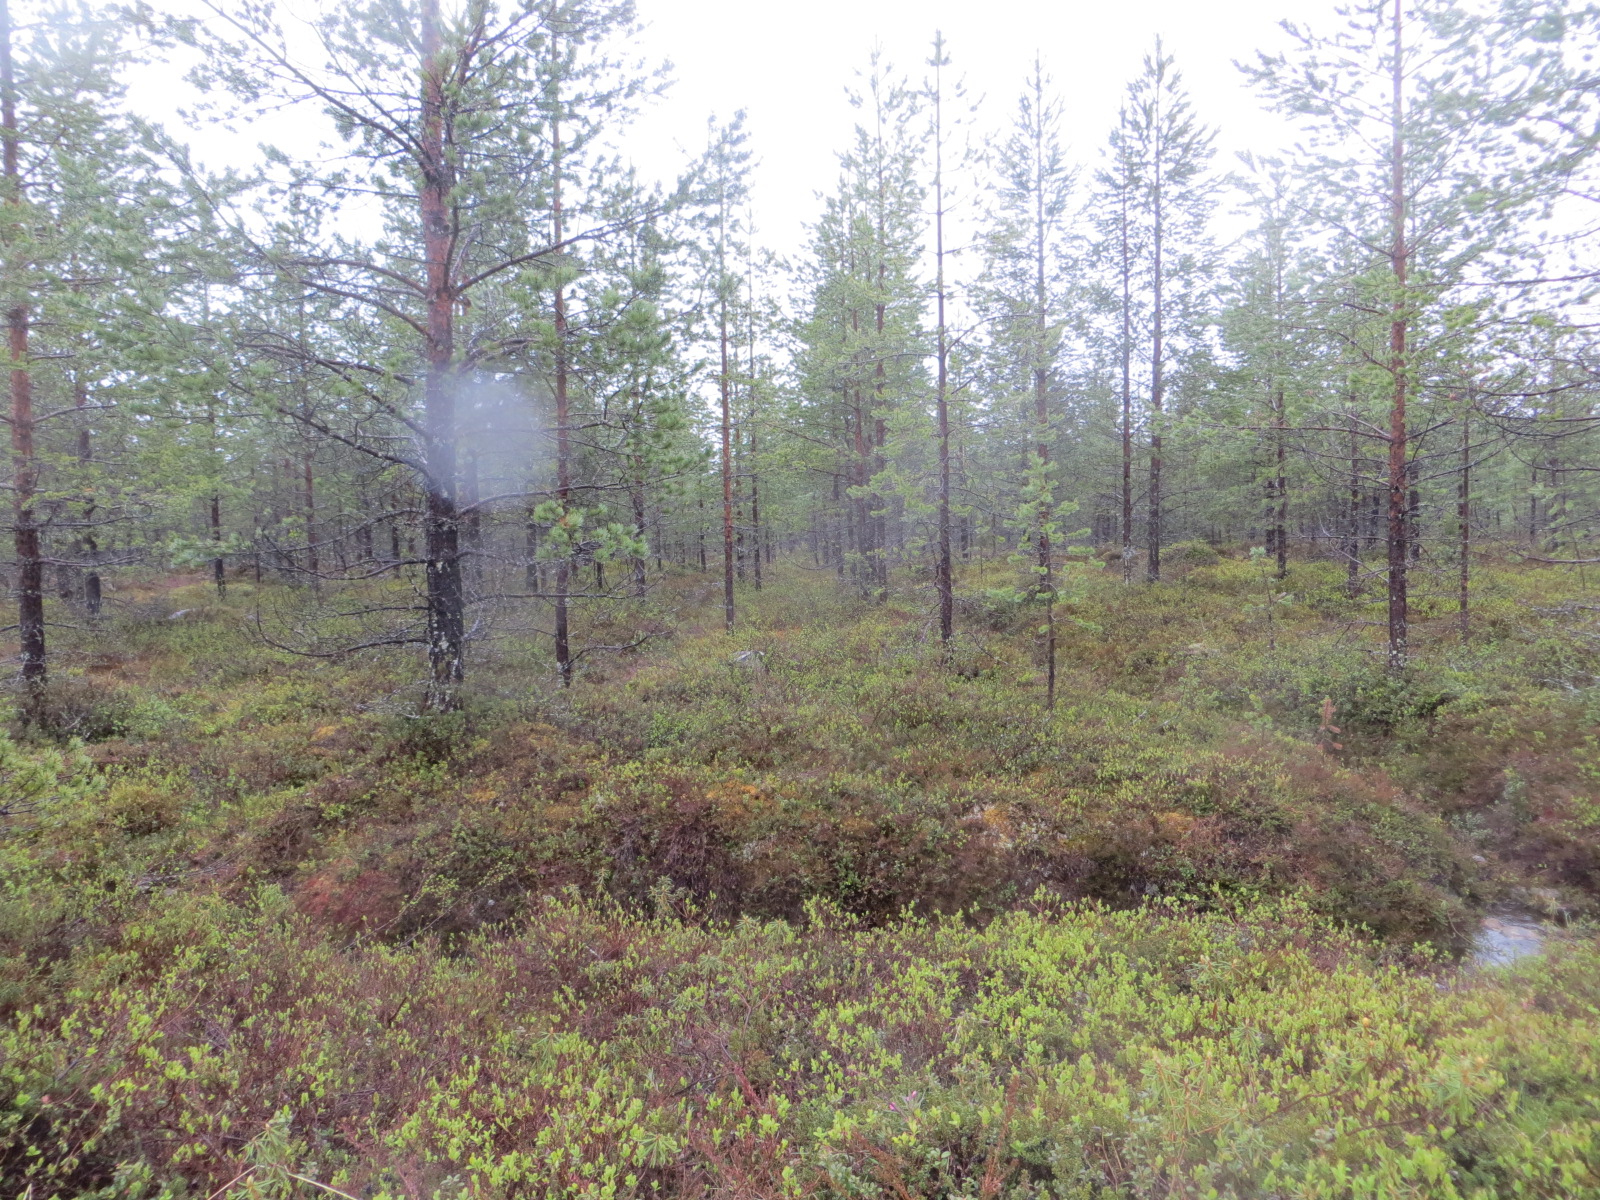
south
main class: Woodland
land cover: Pine dominated coniferous woodland
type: mire and swamp forests
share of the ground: 25 - 50 %
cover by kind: shrubs 60 %, coniferous forest trees 40 %
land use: Forestry
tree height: > 5 m
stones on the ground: < 10 %
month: June
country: FI
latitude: 66.9777
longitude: 25.9457
